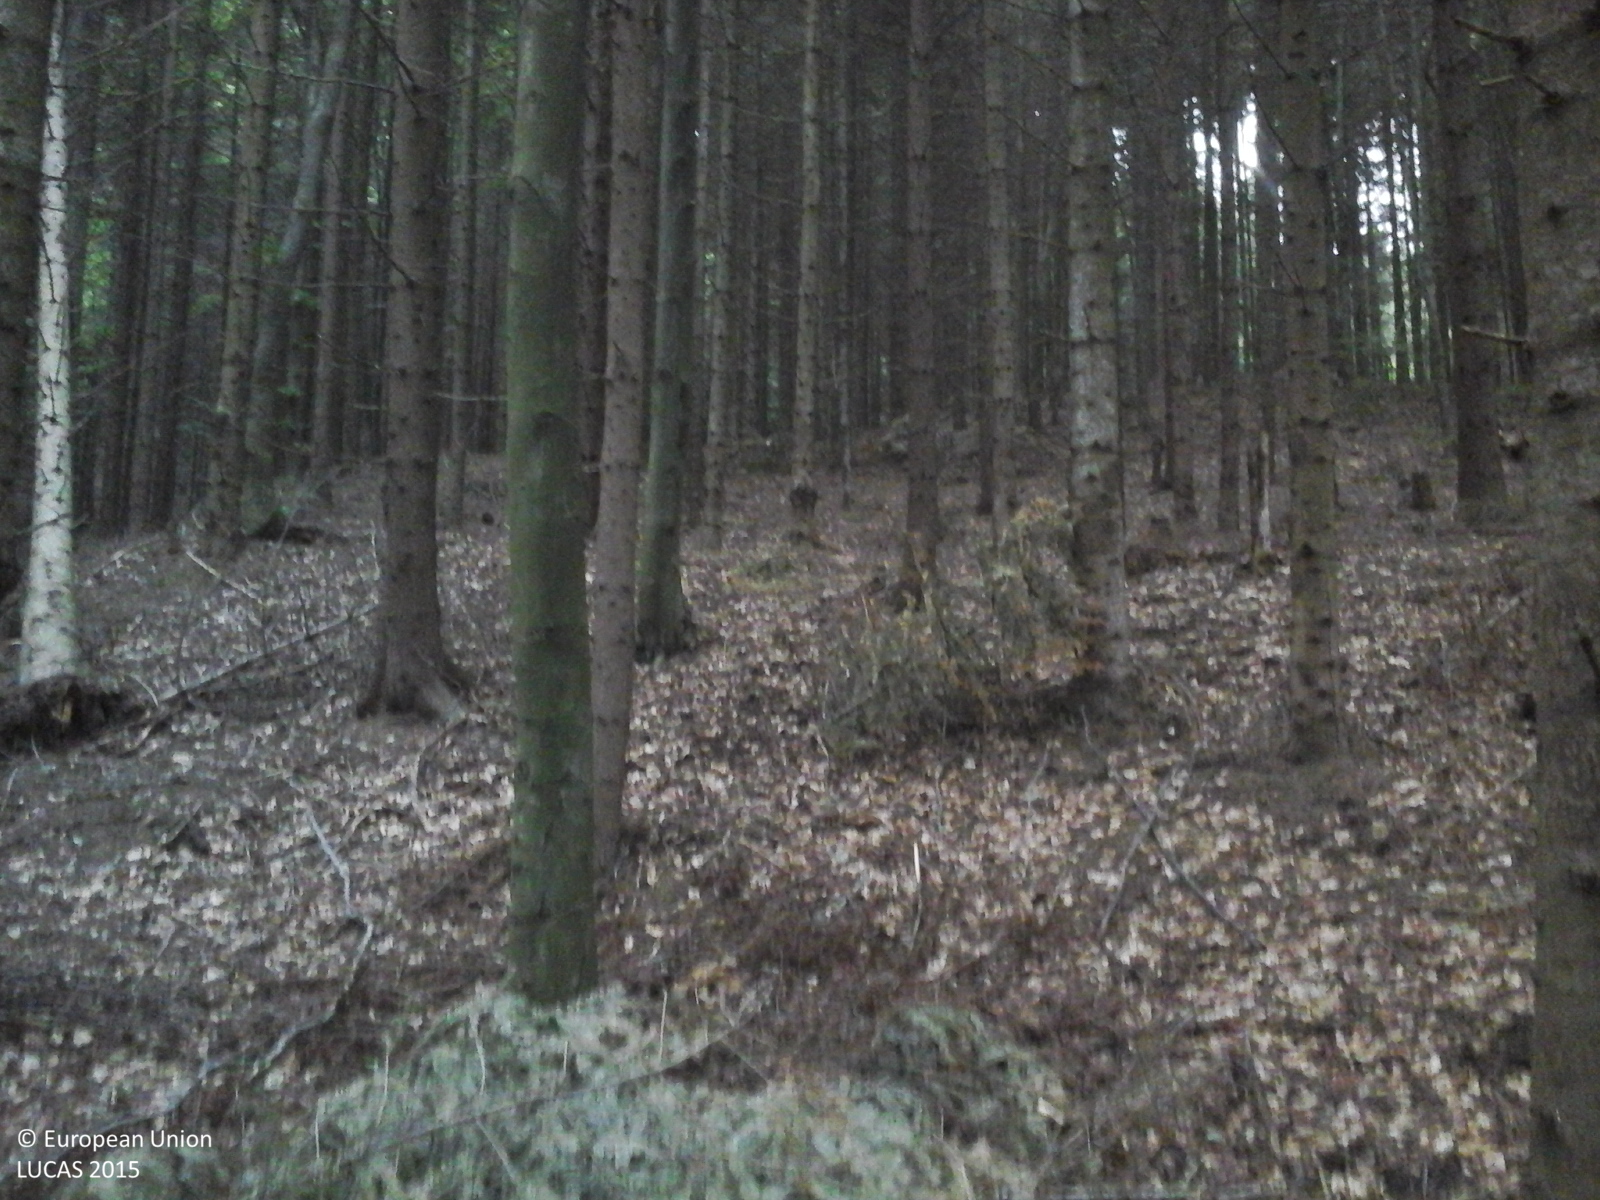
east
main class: Woodland
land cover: Spruce dominated coniferous woodland
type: alpine coniferous forest
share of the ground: > 75 %
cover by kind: coniferous forest trees 100 %
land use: Forestry
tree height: > 5 m
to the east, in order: Spruce dominated coniferous woodland; Other mixed woodland
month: June
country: RO
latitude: 47.1131
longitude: 26.2772
